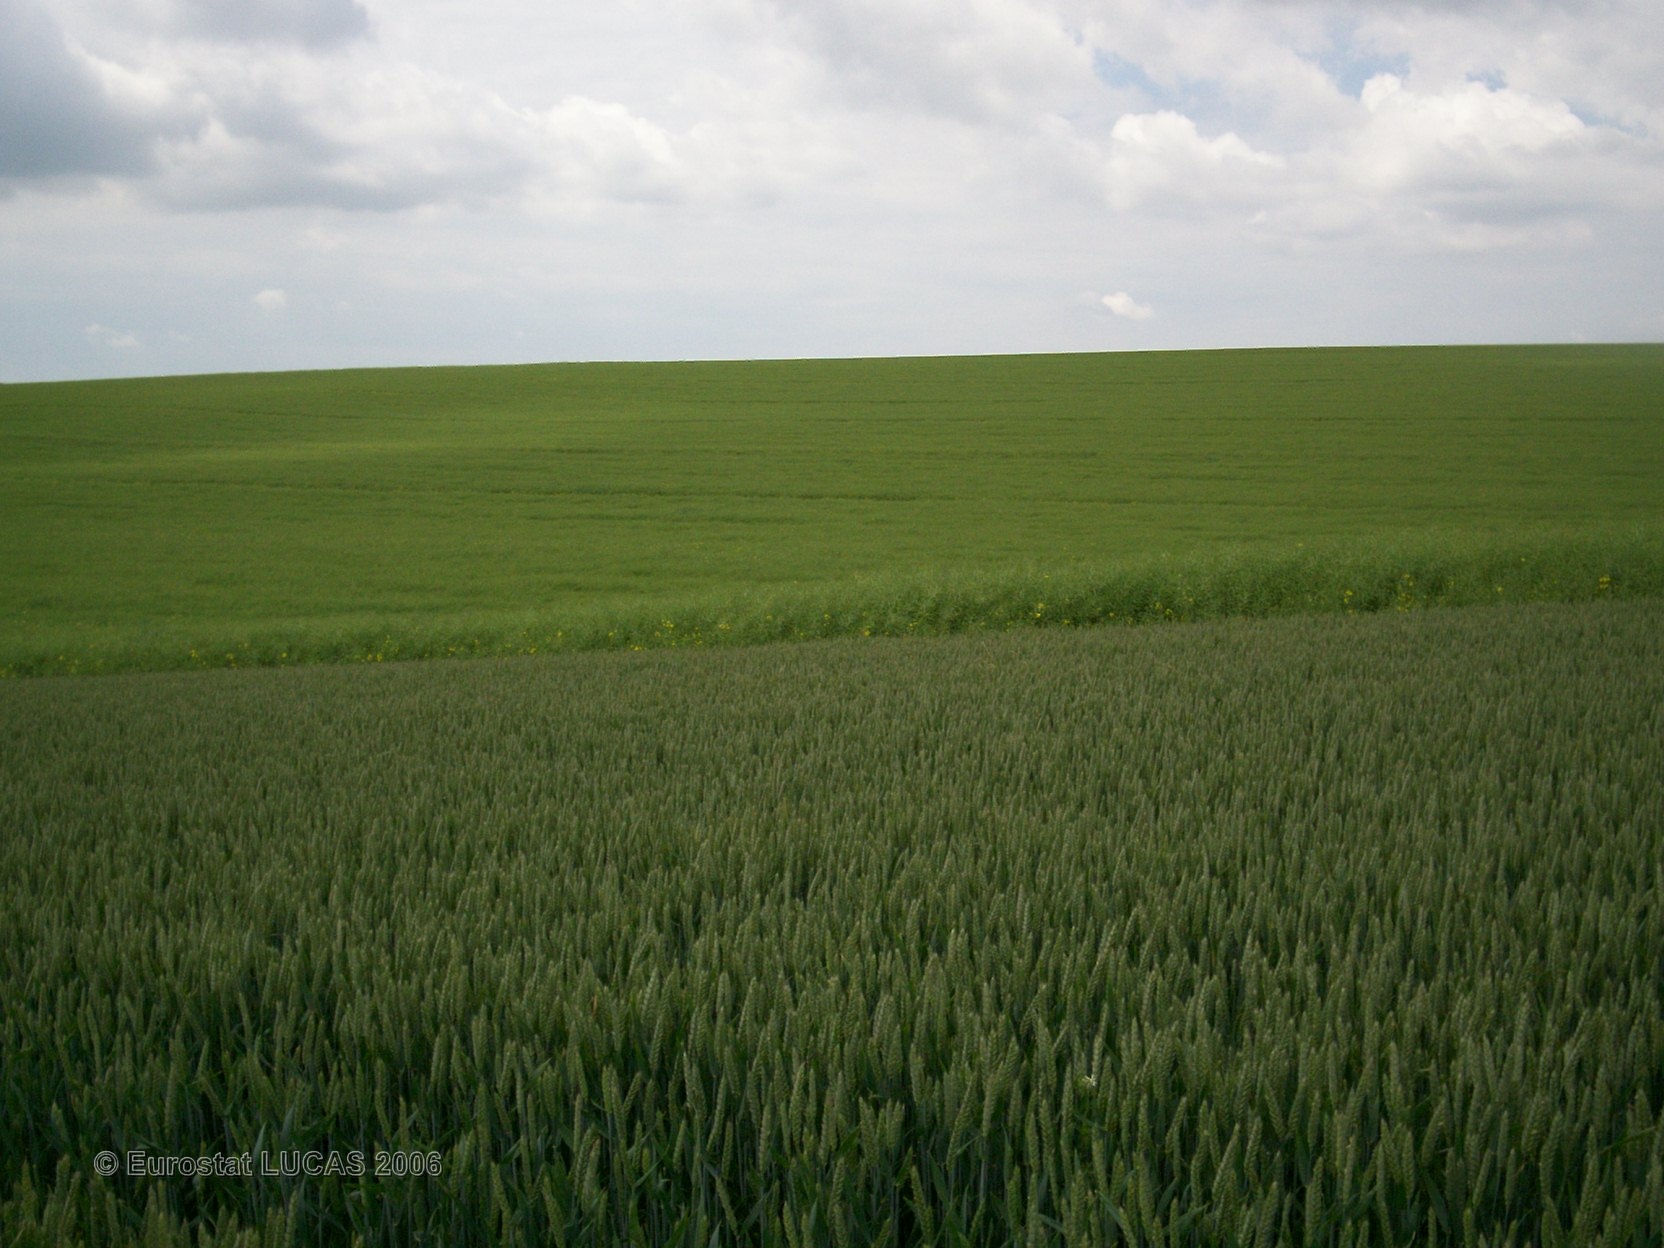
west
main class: Cropland
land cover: Common wheat
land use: Agriculture (excluding fallow land and kitchen gardens)
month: June
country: FR
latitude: 48.6081
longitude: 4.4771
